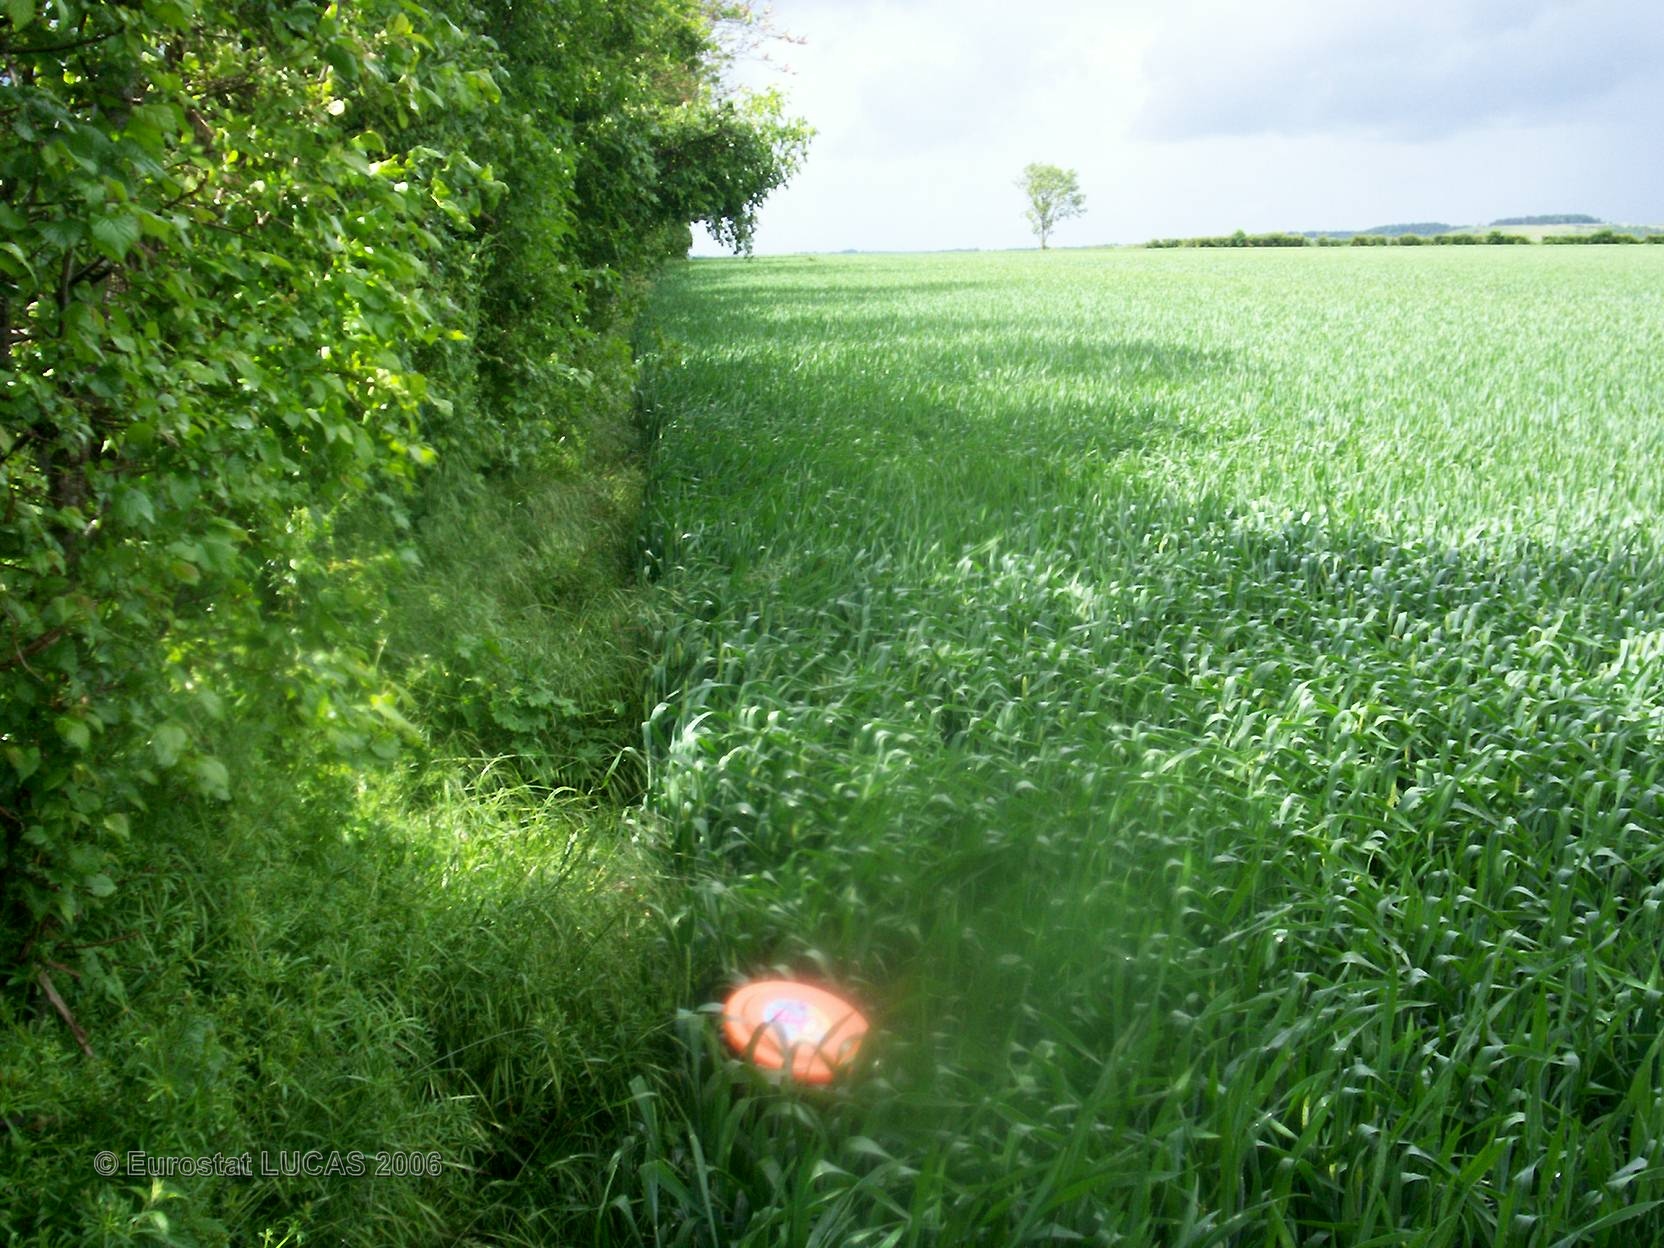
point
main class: Cropland
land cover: Common wheat
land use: Agriculture (excluding fallow land and kitchen gardens)
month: May
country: FR
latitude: 48.8972
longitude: -0.1397
